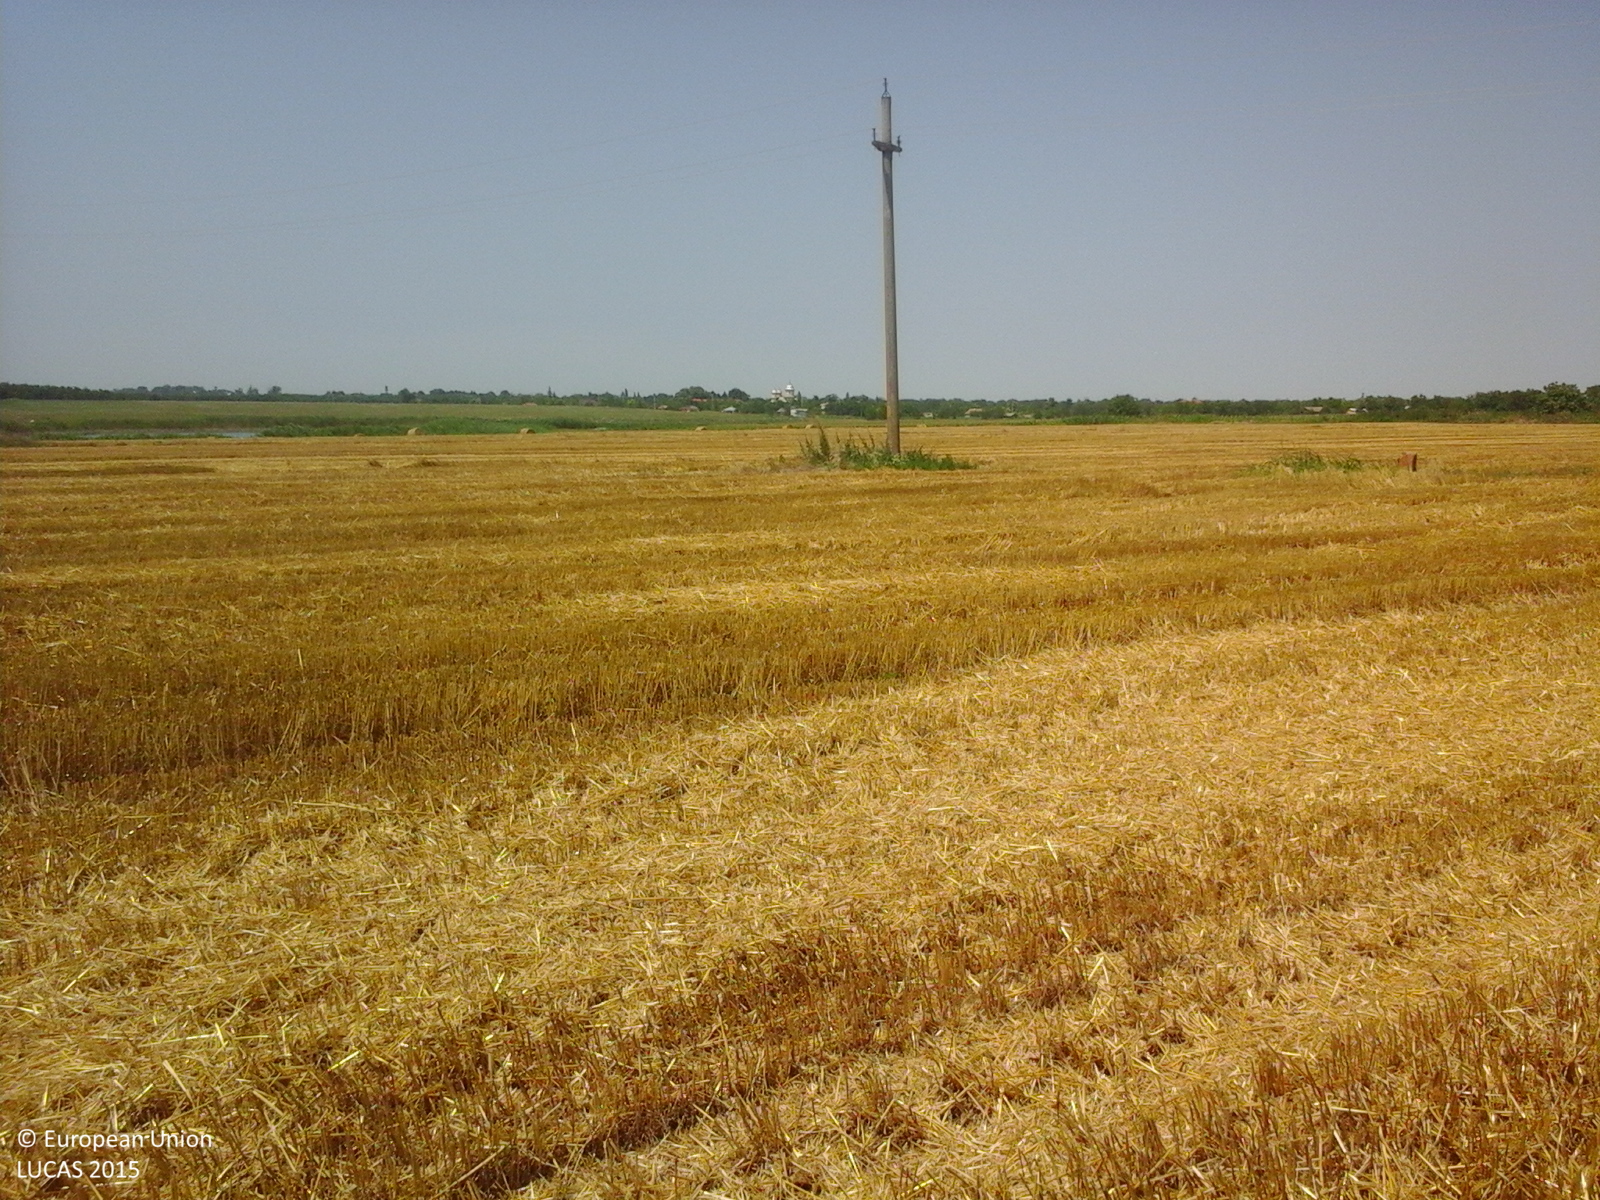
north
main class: Cropland
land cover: Common wheat
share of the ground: > 75 %
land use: Agriculture (excluding fallow land and kitchen gardens)
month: July
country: RO
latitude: 44.7019
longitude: 27.1088
